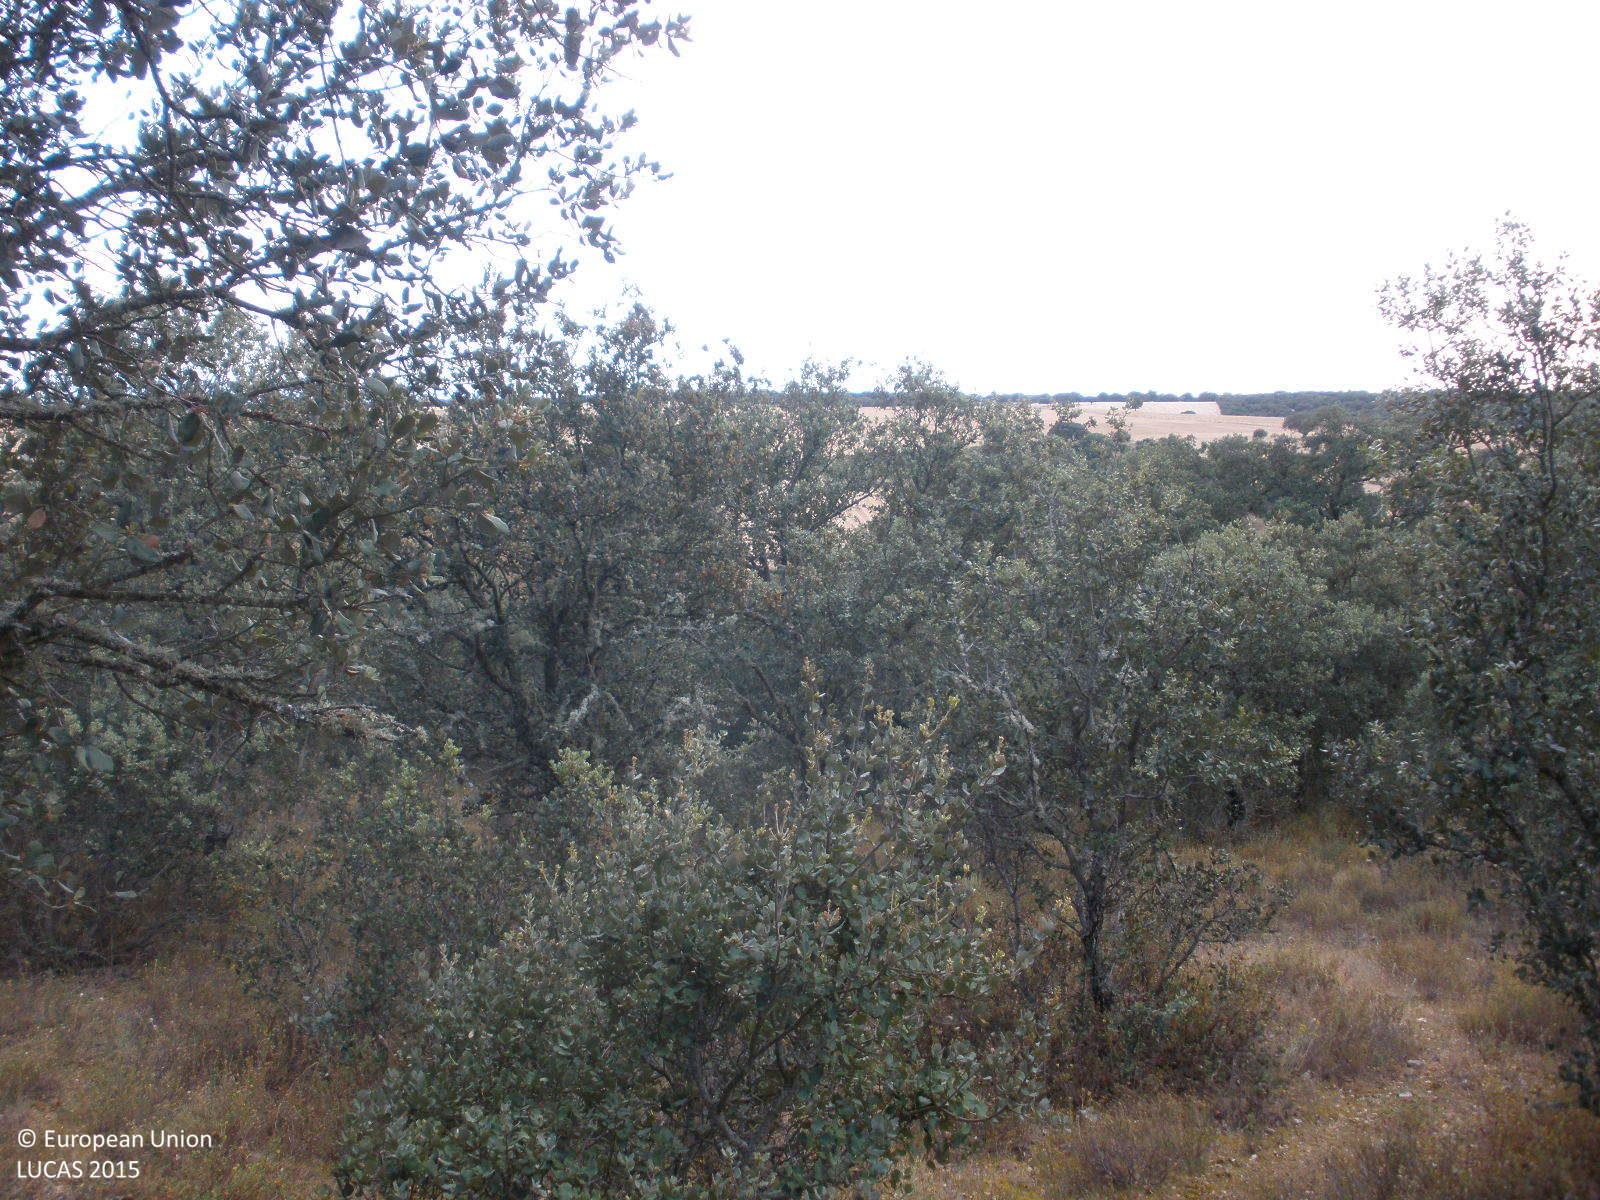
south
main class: Woodland
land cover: Broadleaved woodland
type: broadleaved evergreen forest
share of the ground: > 75 %
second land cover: Shrubland without tree cover
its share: 25 - 50 %
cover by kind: broadleaved forest trees 70 %, shrubs 30 %
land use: Forestry
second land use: Agriculture (excluding fallow land and kitchen gardens)
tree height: > 5 m
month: June
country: ES
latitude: 40.7505
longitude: -6.2047
